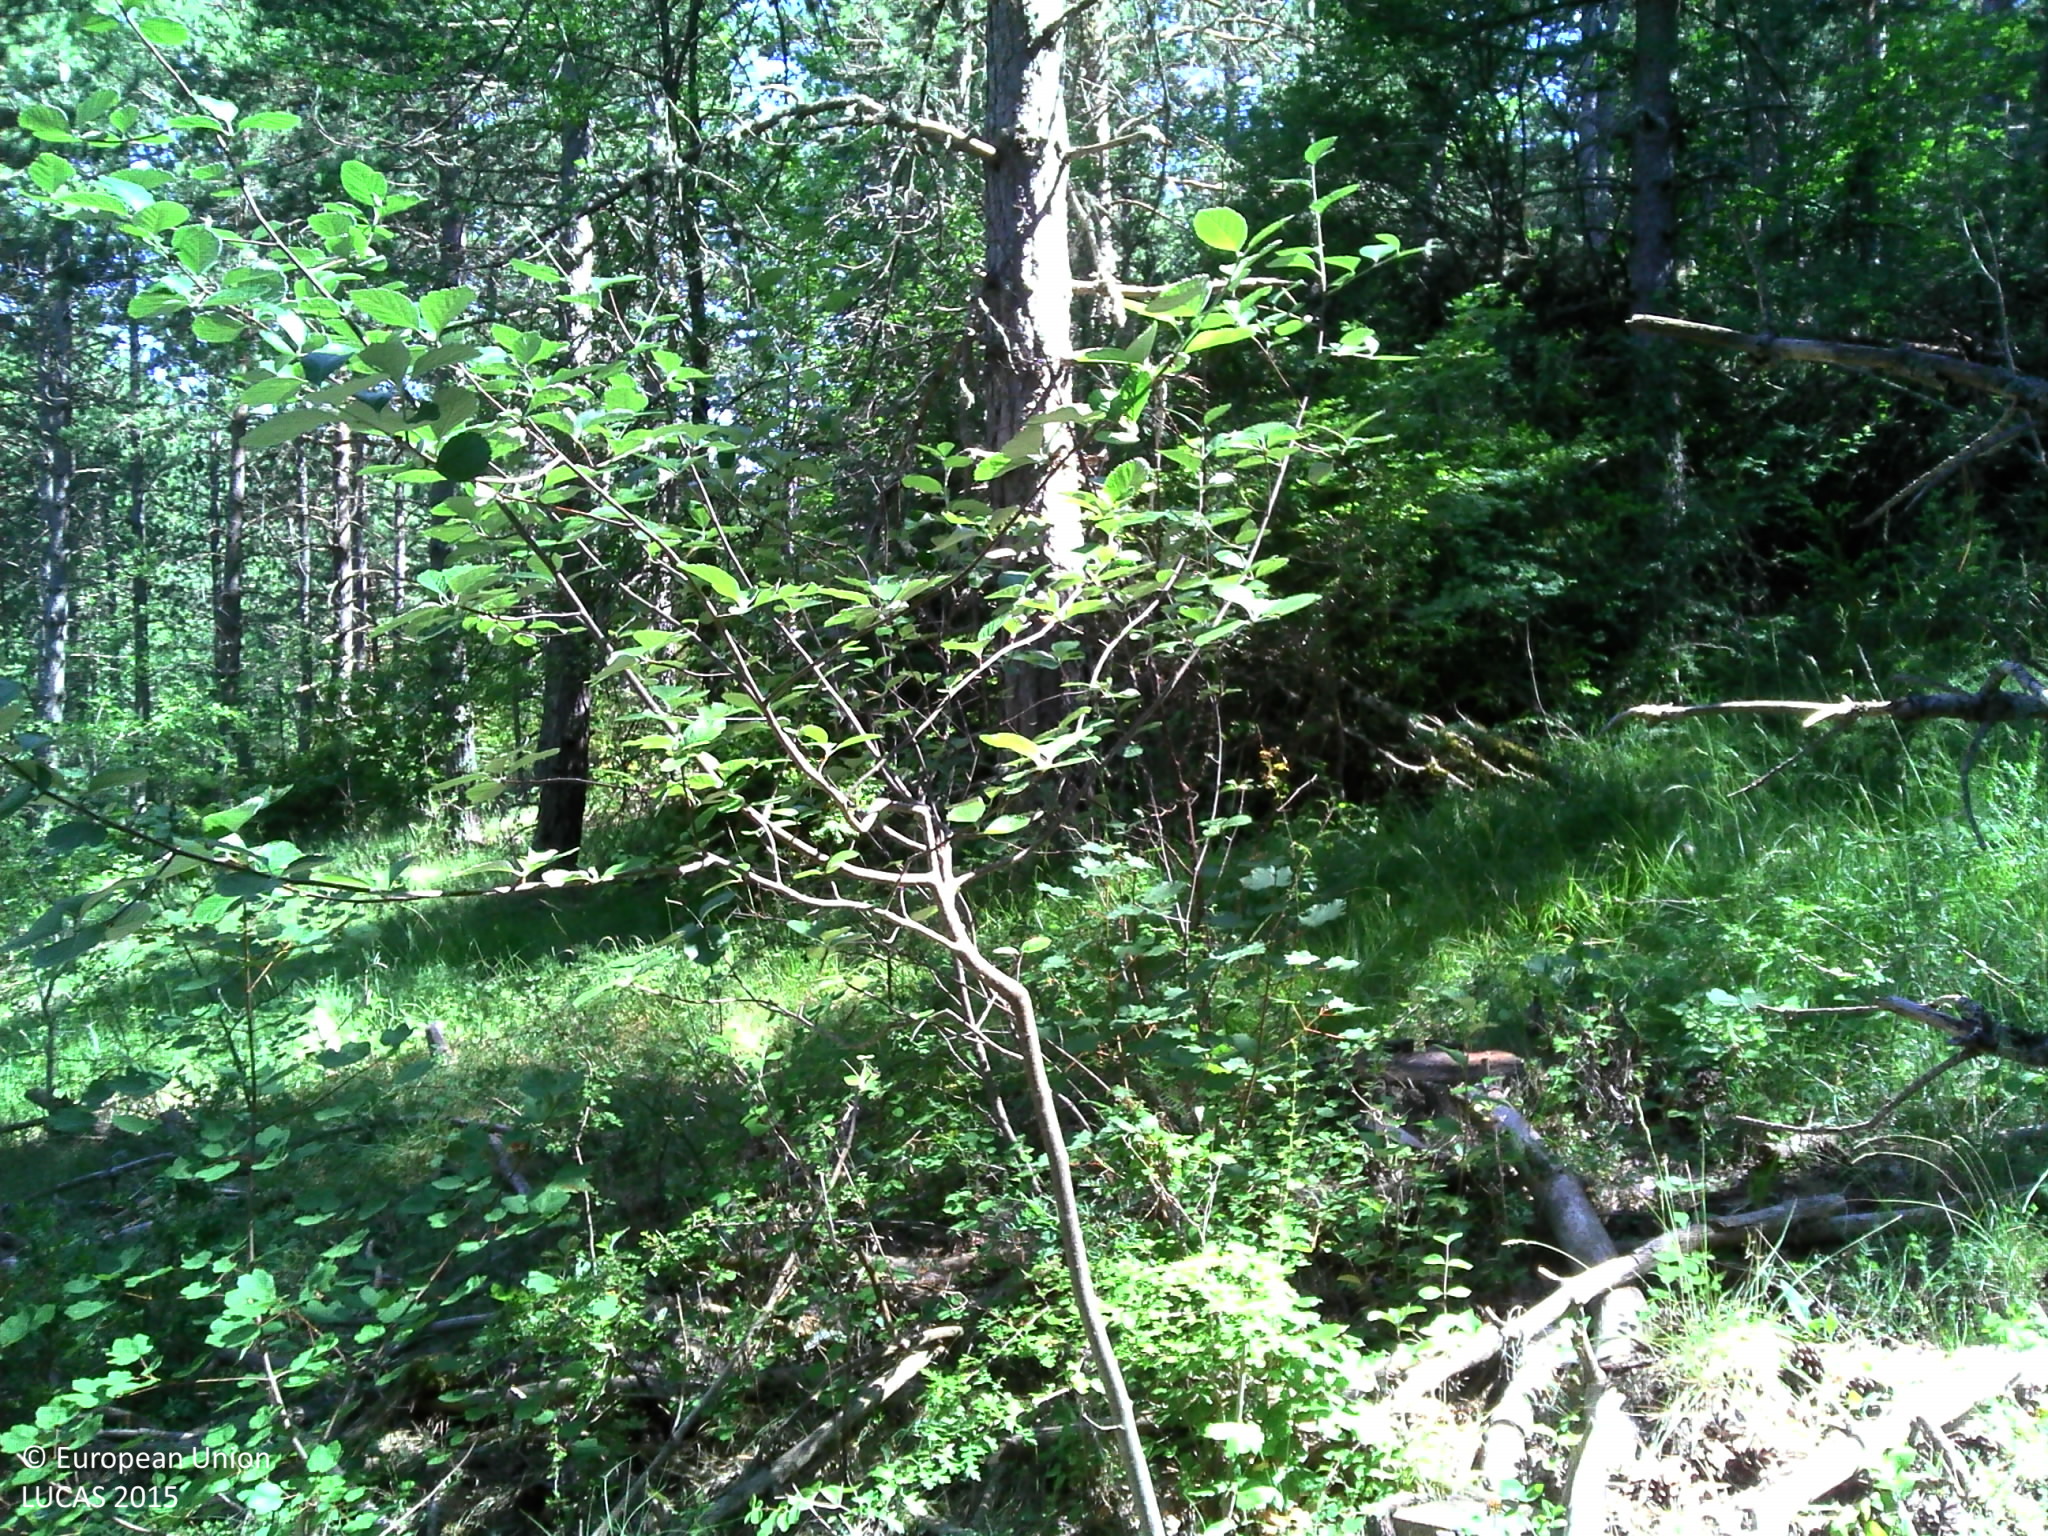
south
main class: Woodland
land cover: Pine dominated coniferous woodland
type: coniferous forest of the mediterranean region
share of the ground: > 75 %
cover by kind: coniferous forest trees 80 %, shrubs 10 %, herbaceous plants 10 %
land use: Forestry
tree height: > 5 m
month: July
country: FR
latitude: 43.8689
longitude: 6.2874
